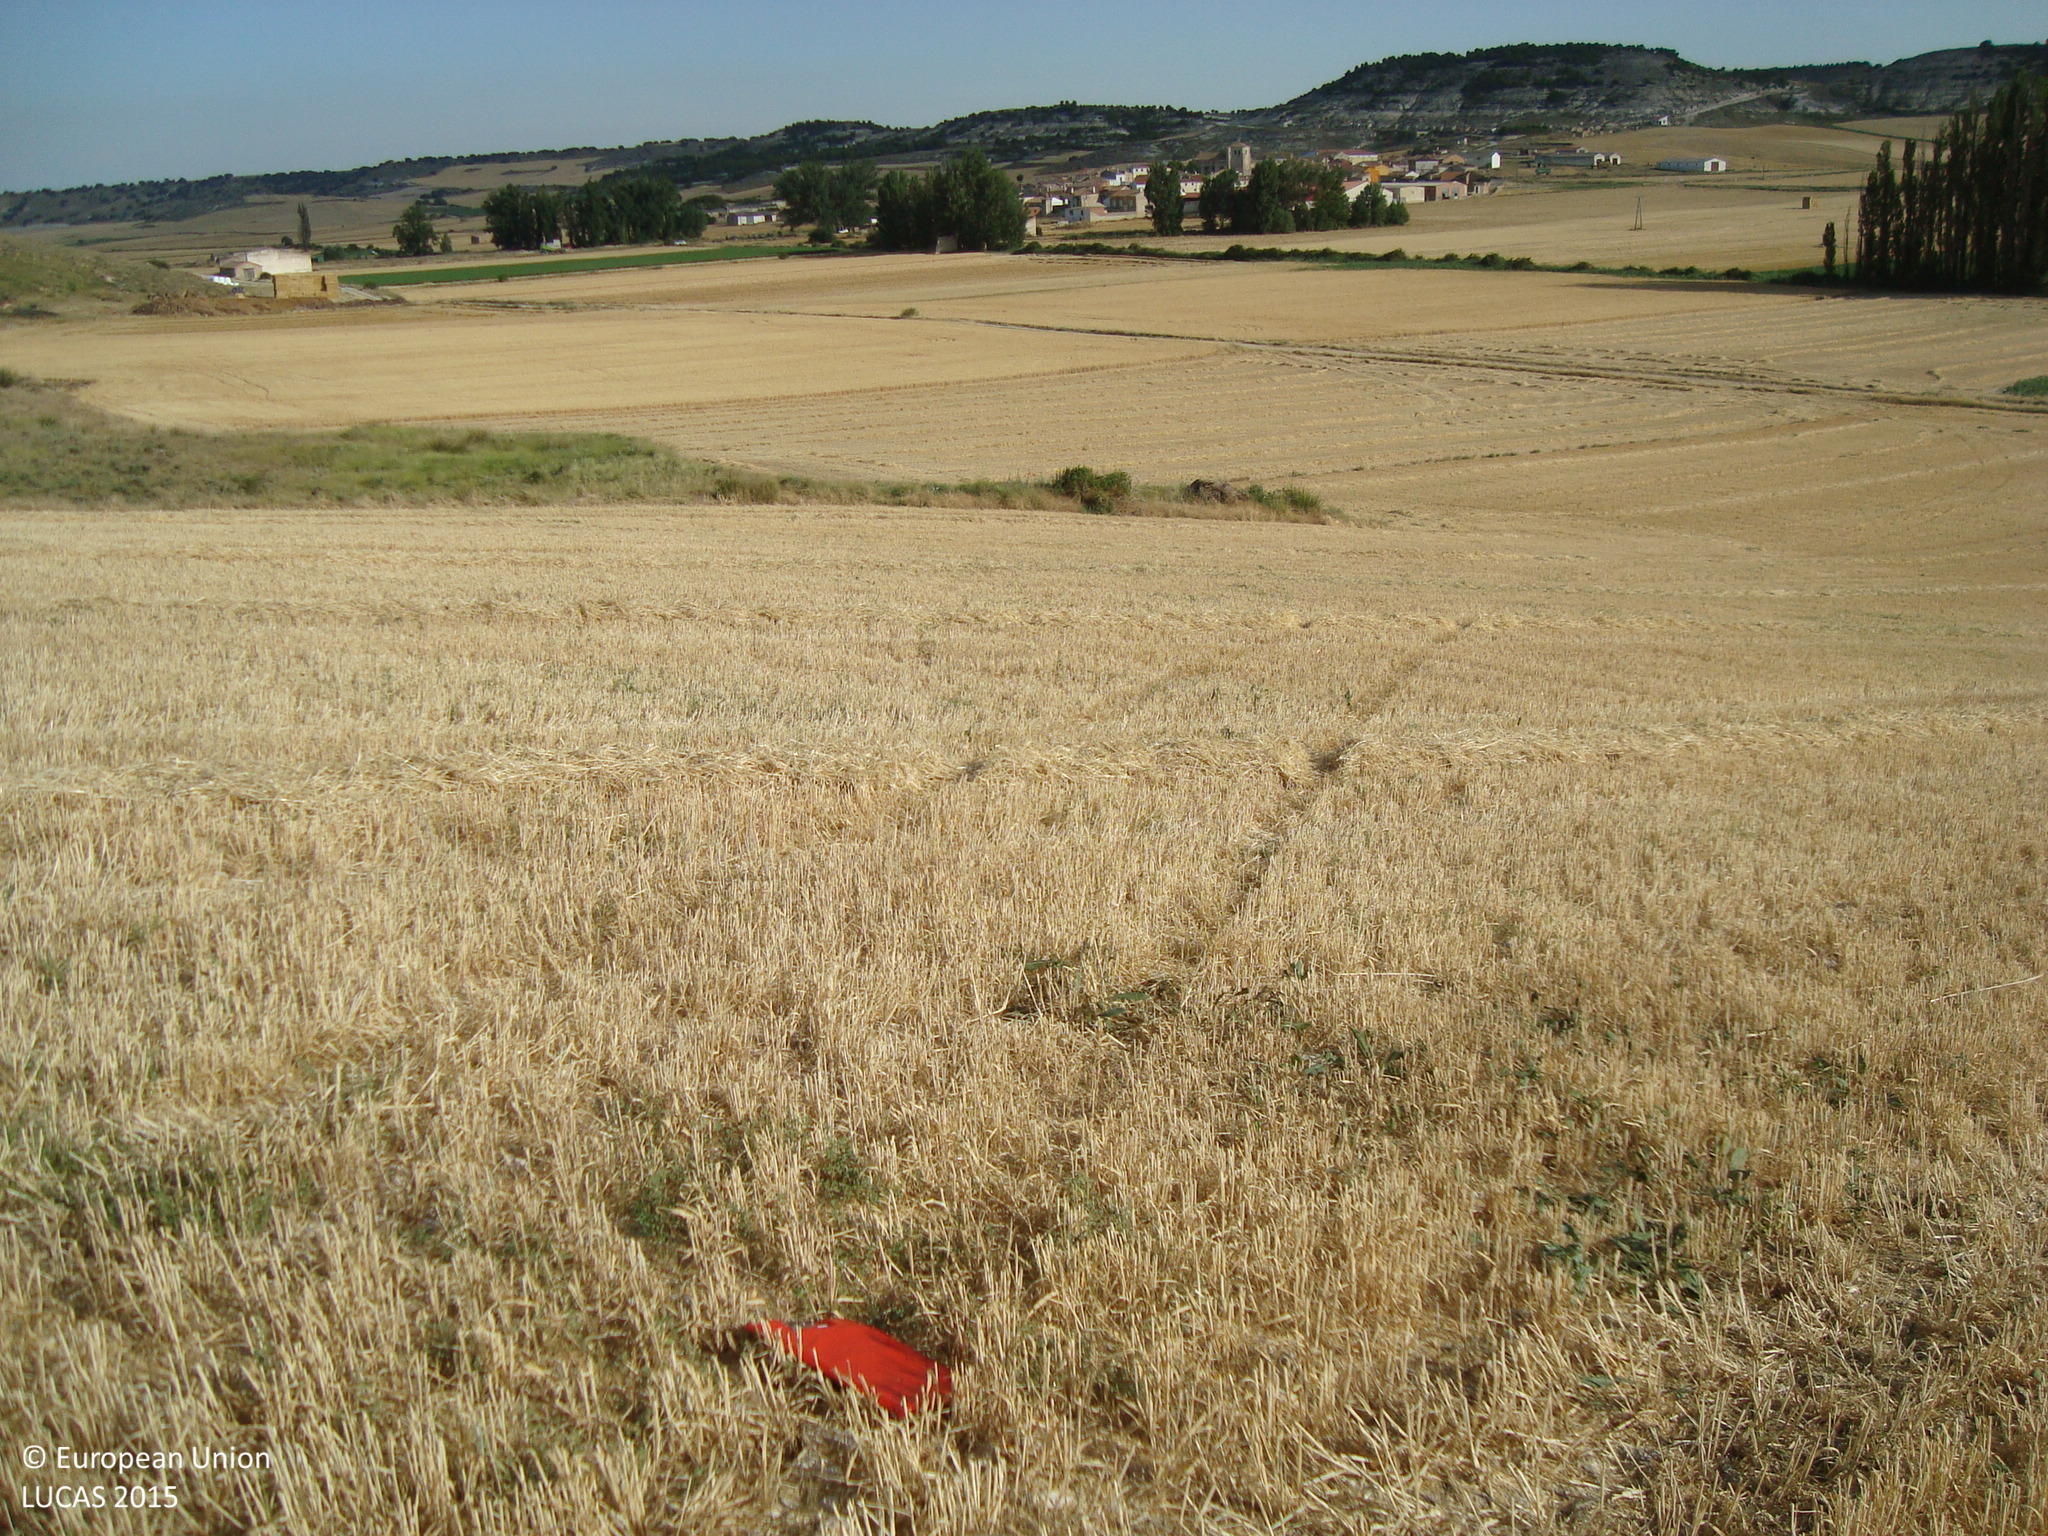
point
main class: Cropland
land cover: Barley
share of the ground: > 75 %
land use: Agriculture (excluding fallow land and kitchen gardens)
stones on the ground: 10 - 25 %
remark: Harvested field
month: July
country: ES
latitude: 41.8648
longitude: -4.2188
